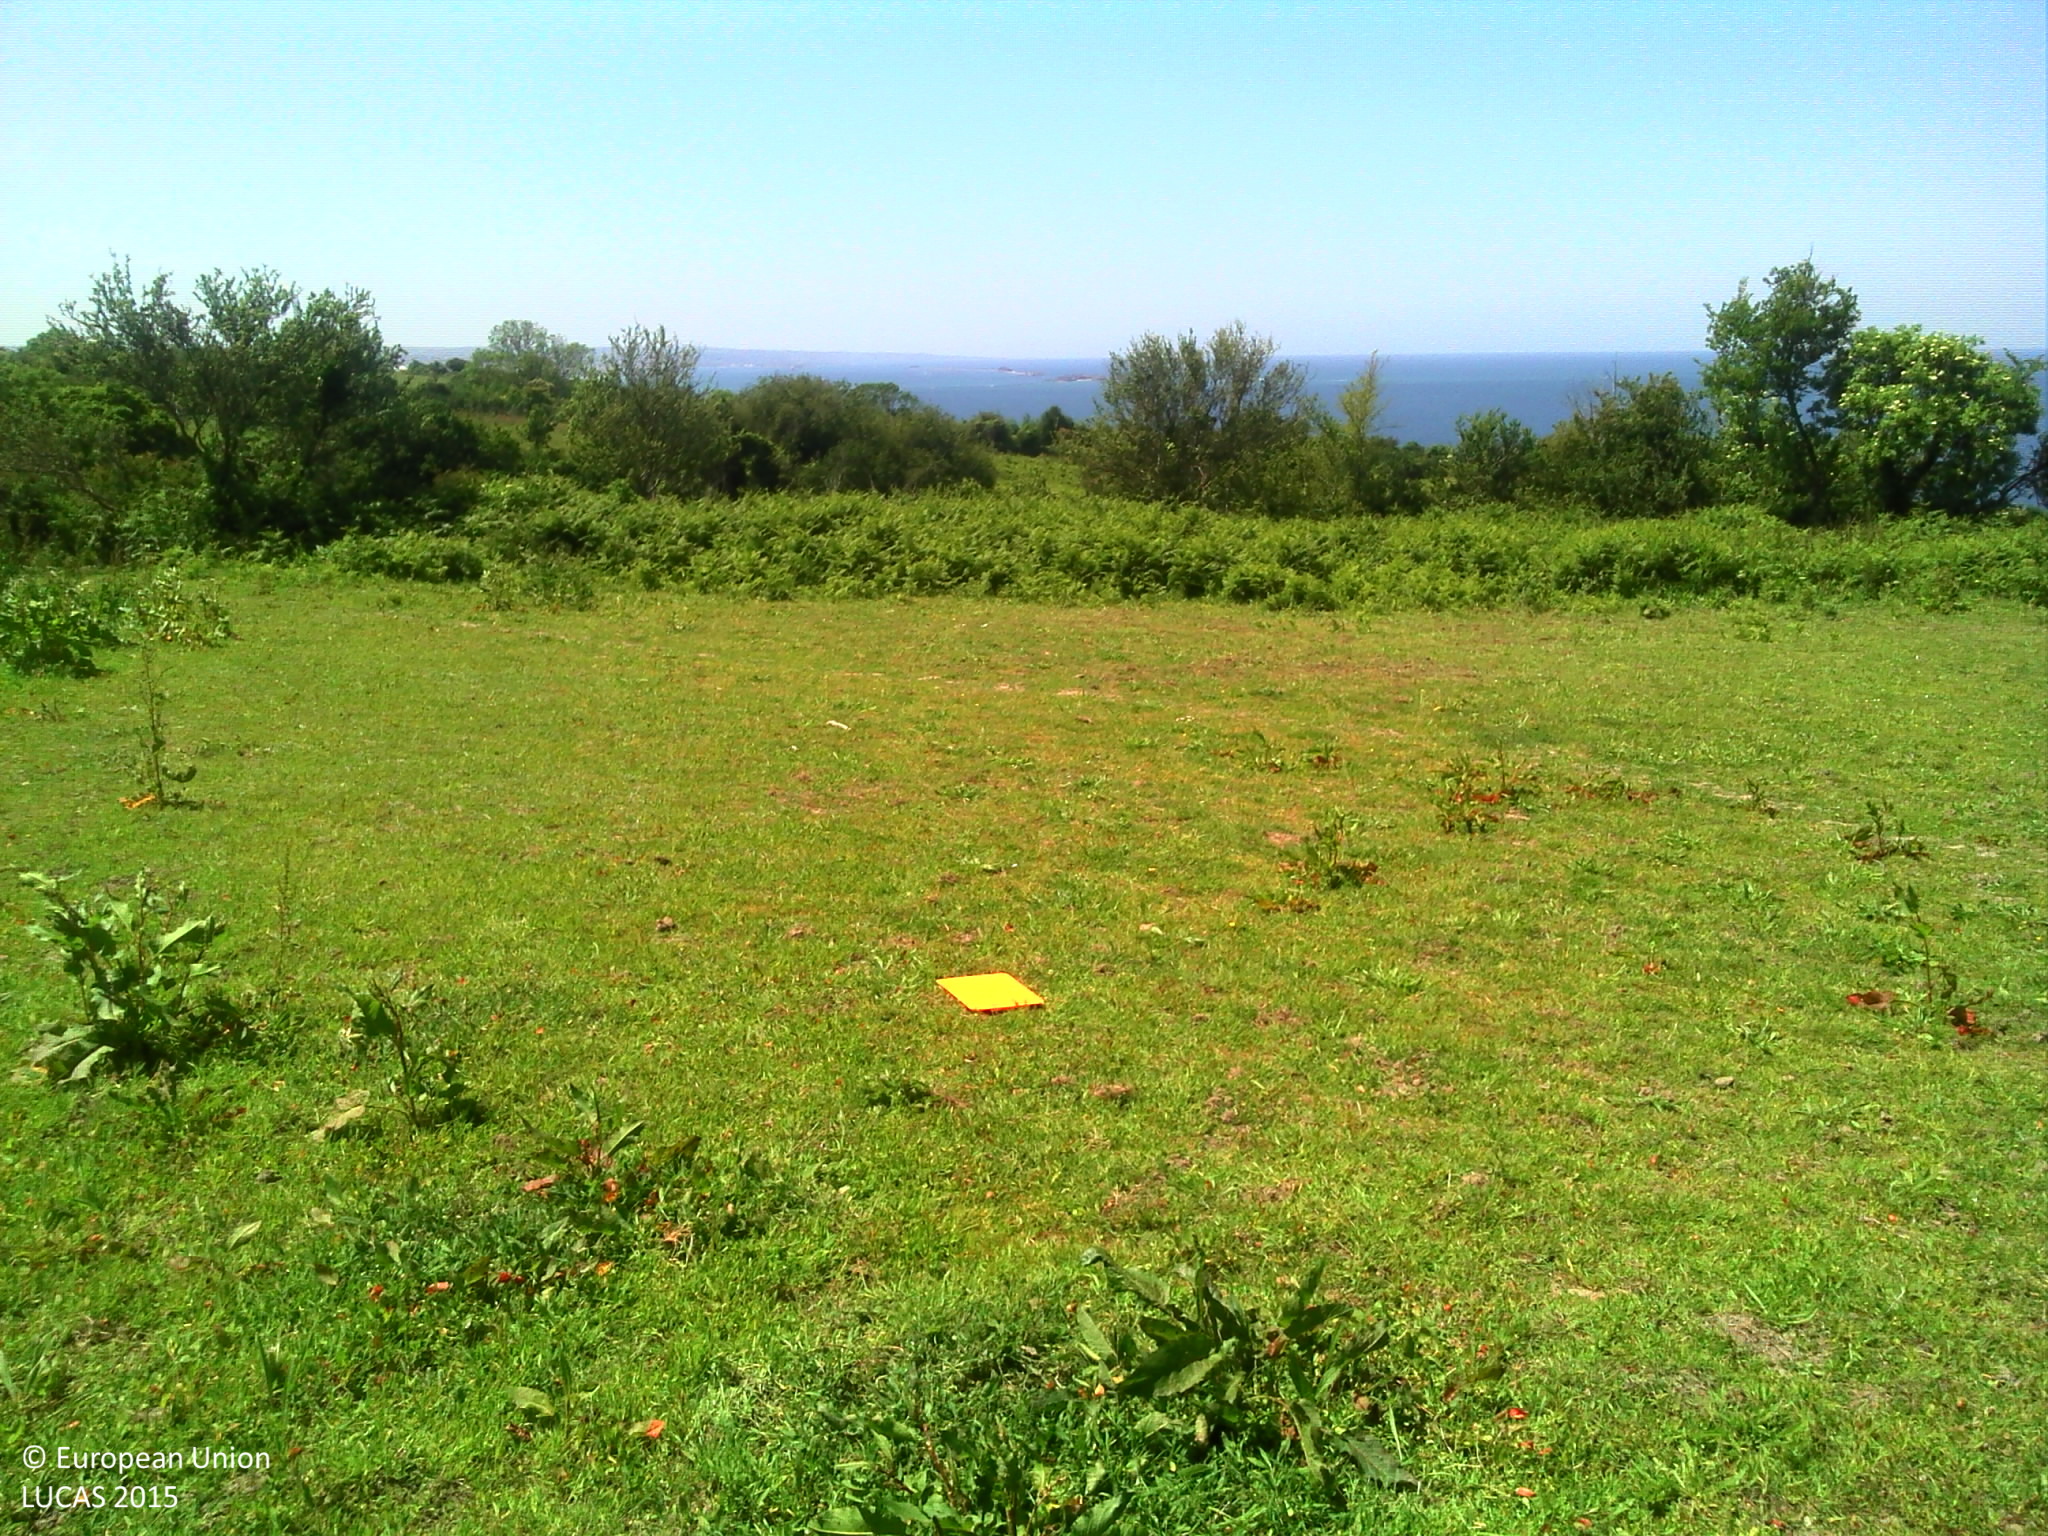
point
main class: Grassland
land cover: Grassland without tree/shrub cover
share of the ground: > 75 %
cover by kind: herbaceous plants 100 %
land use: Agriculture (excluding fallow land and kitchen gardens)
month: June
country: FR
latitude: 49.6541
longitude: -1.5051
